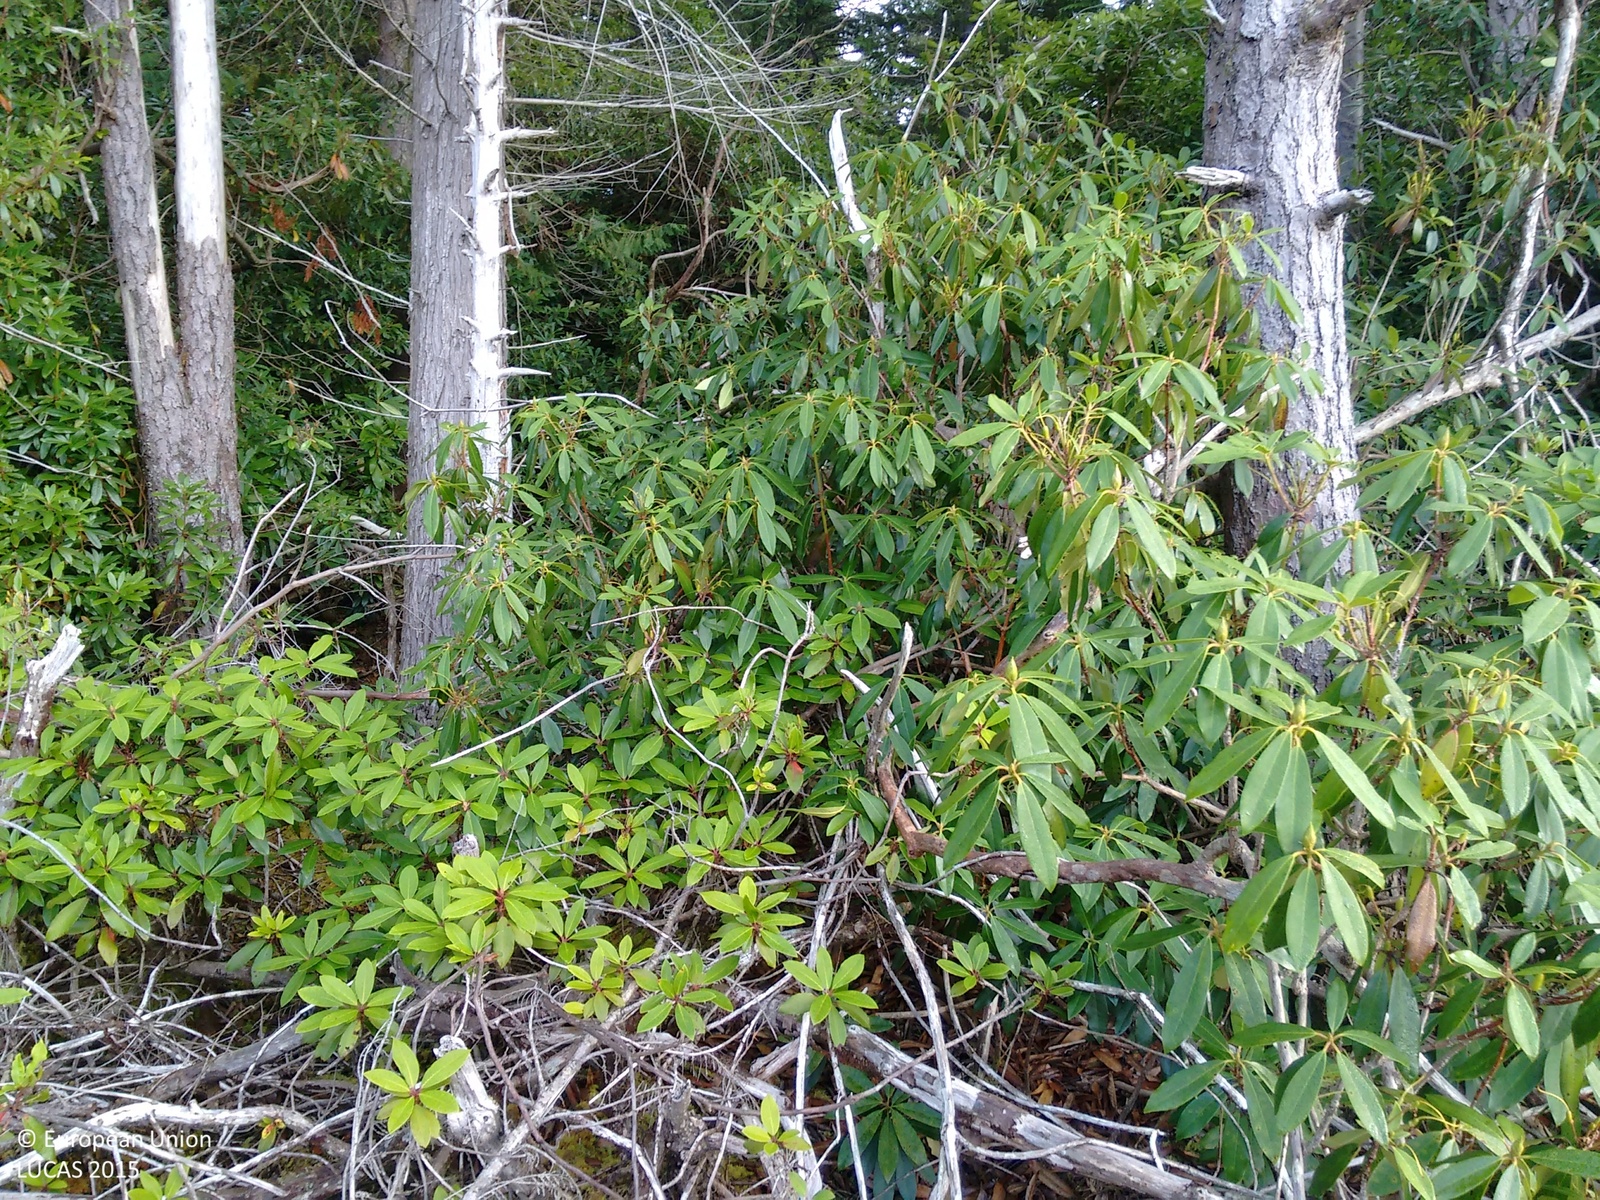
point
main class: Woodland
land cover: Spruce dominated mixed woodland
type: exotic forest
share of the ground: 50 - 75 %
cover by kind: coniferous forest trees 40 %, broadleaved forest trees 25 %, unconsolidated bare surface 25 %, shrubs 5 %, herbaceous plants 5 %
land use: Forestry
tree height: > 5 m
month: November
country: GB
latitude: 57.4781
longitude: -5.3373
